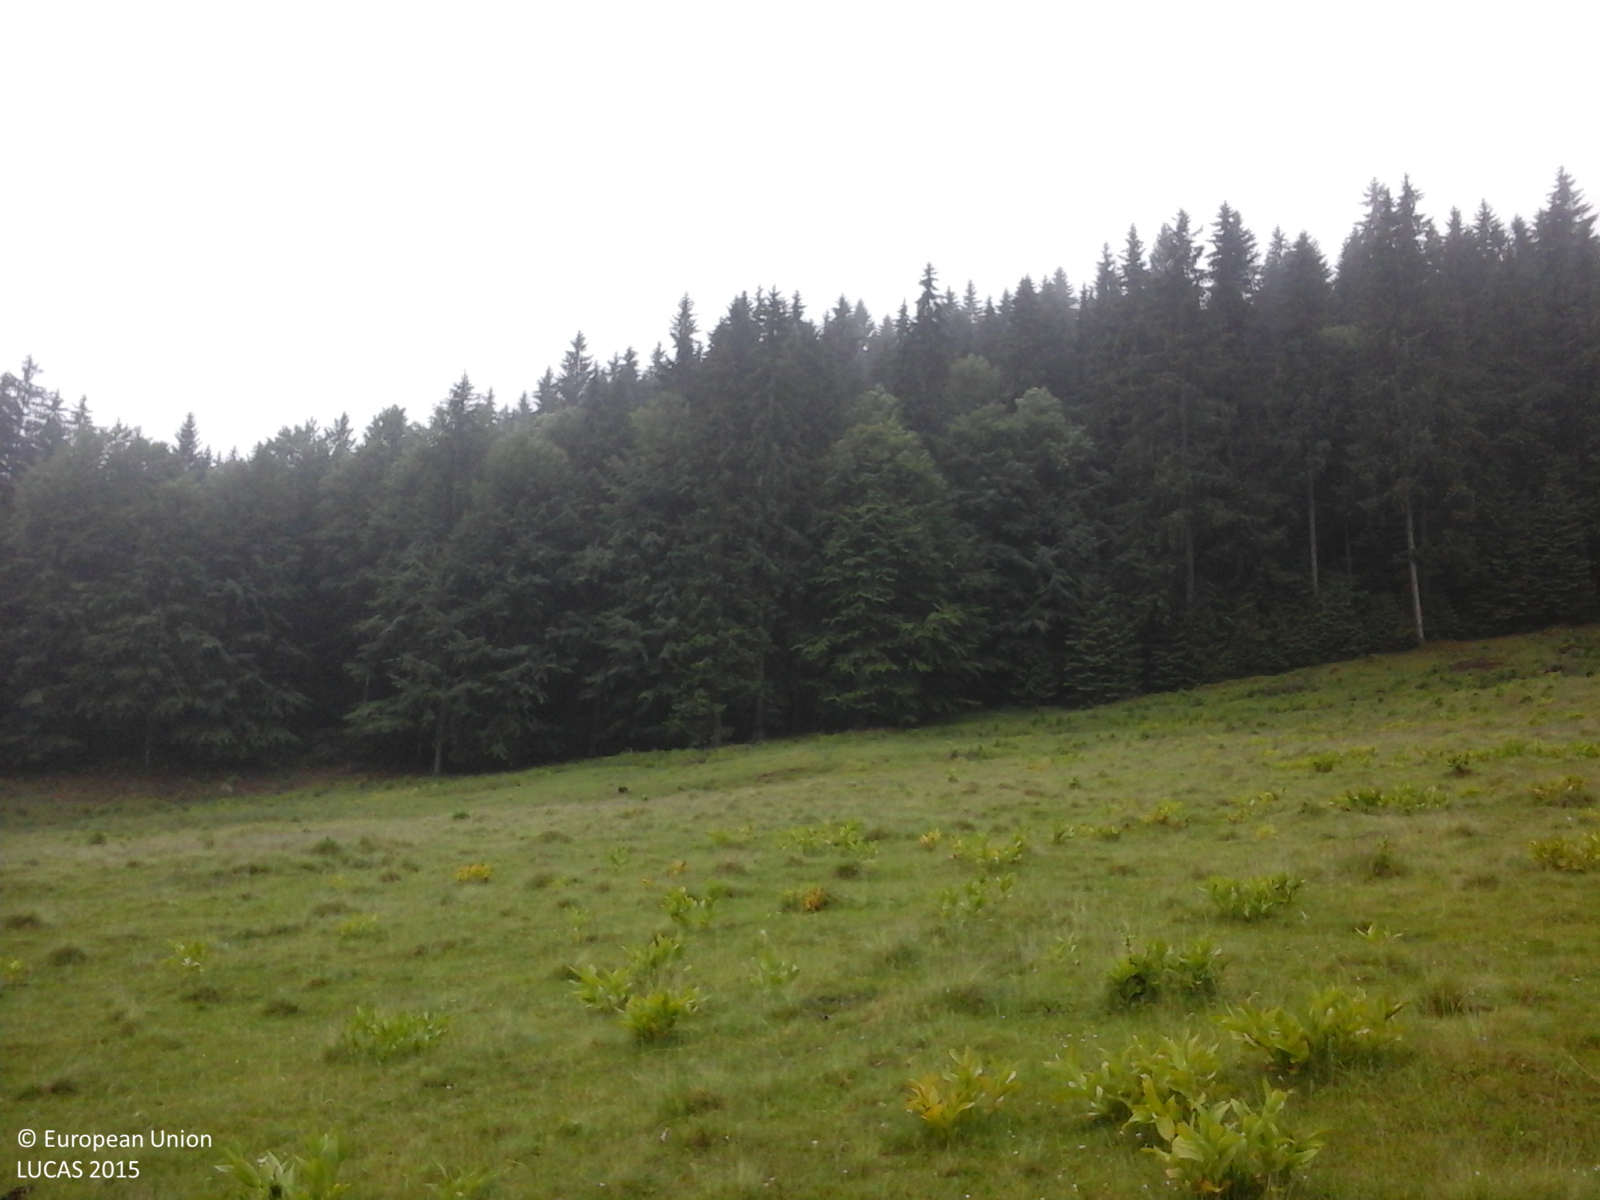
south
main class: Grassland
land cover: Grassland without tree/shrub cover
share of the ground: > 75 %
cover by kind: herbaceous plants 100 %
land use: Agriculture (excluding fallow land and kitchen gardens)
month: June
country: RO
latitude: 47.3270
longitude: 25.8293
